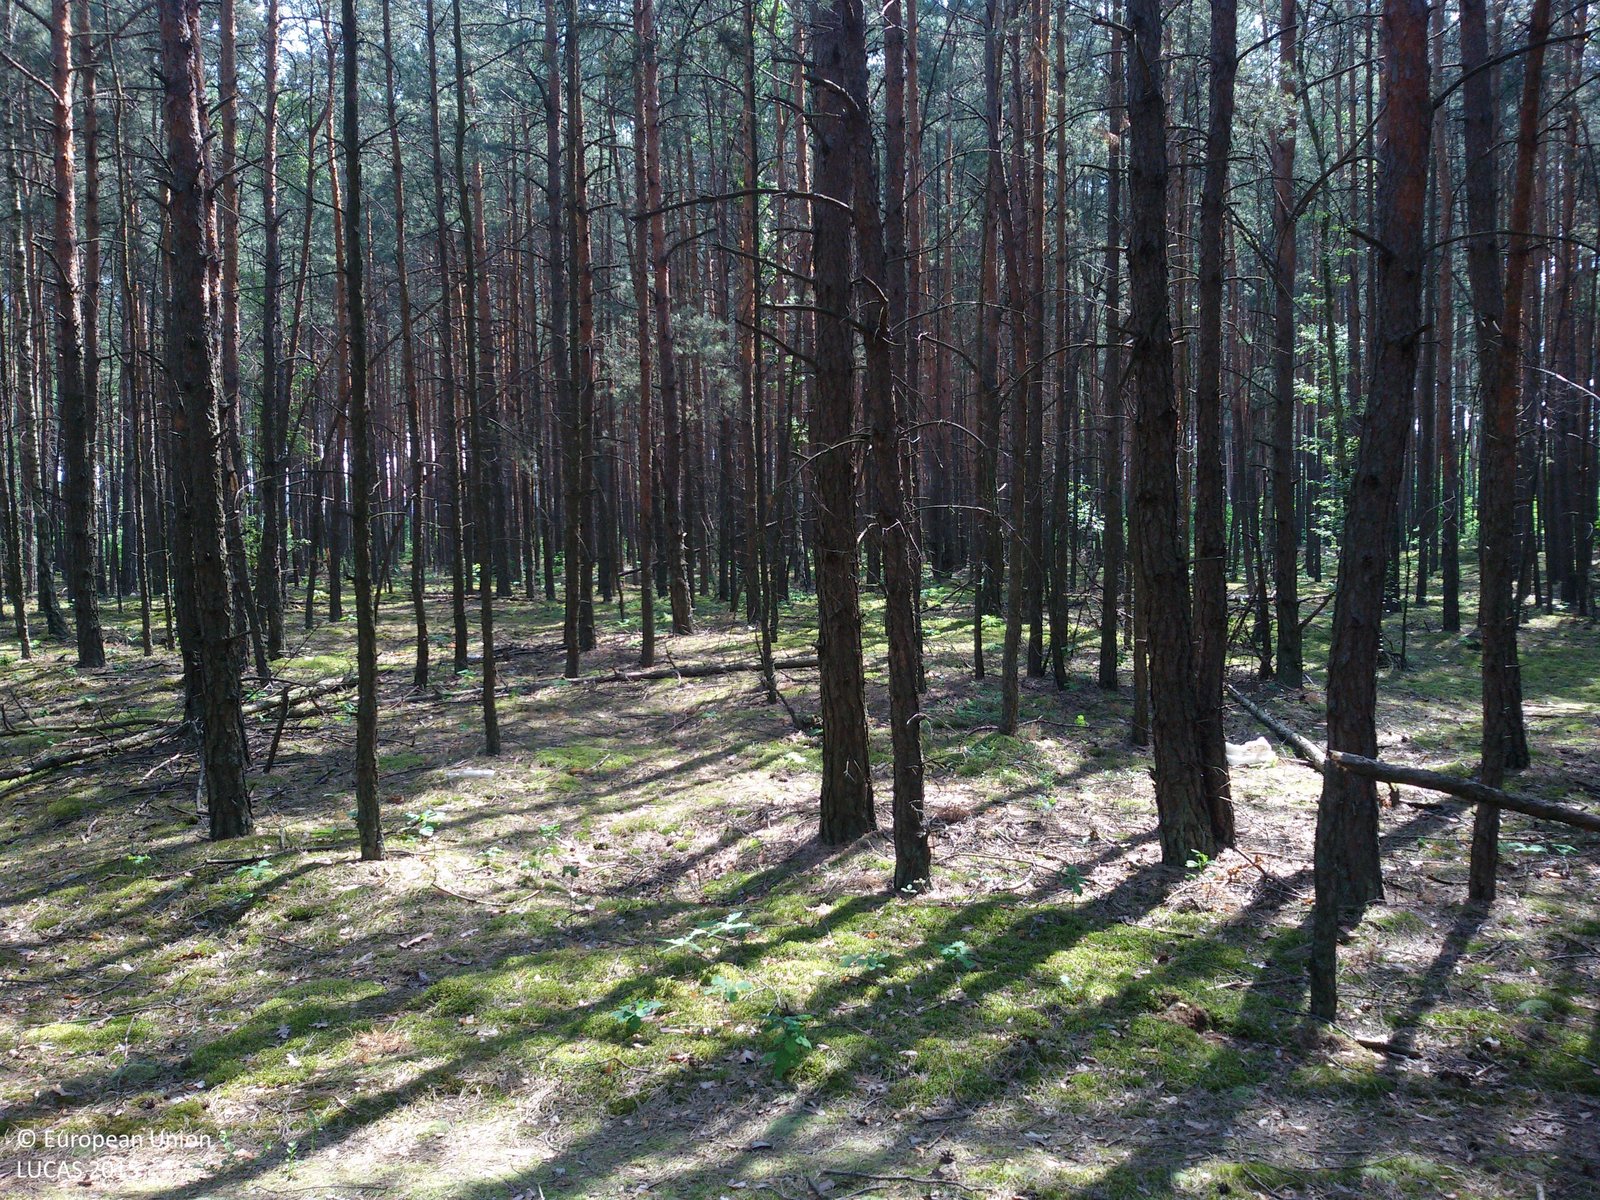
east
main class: Woodland
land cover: Pine dominated coniferous woodland
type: hemiboreal forest and nemoral coniferous forest and mixed broadleaved-coniferous forest
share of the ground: > 75 %
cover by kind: coniferous forest trees 95 %, herbaceous plants 5 %
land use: Forestry
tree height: > 5 m
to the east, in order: Pine dominated coniferous woodland; Tracks; Pine dominated coniferous woodland; Tracks; Pine dominated coniferous woodland; Broadleaved woodland
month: June
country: PL
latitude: 51.4263
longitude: 20.6397
